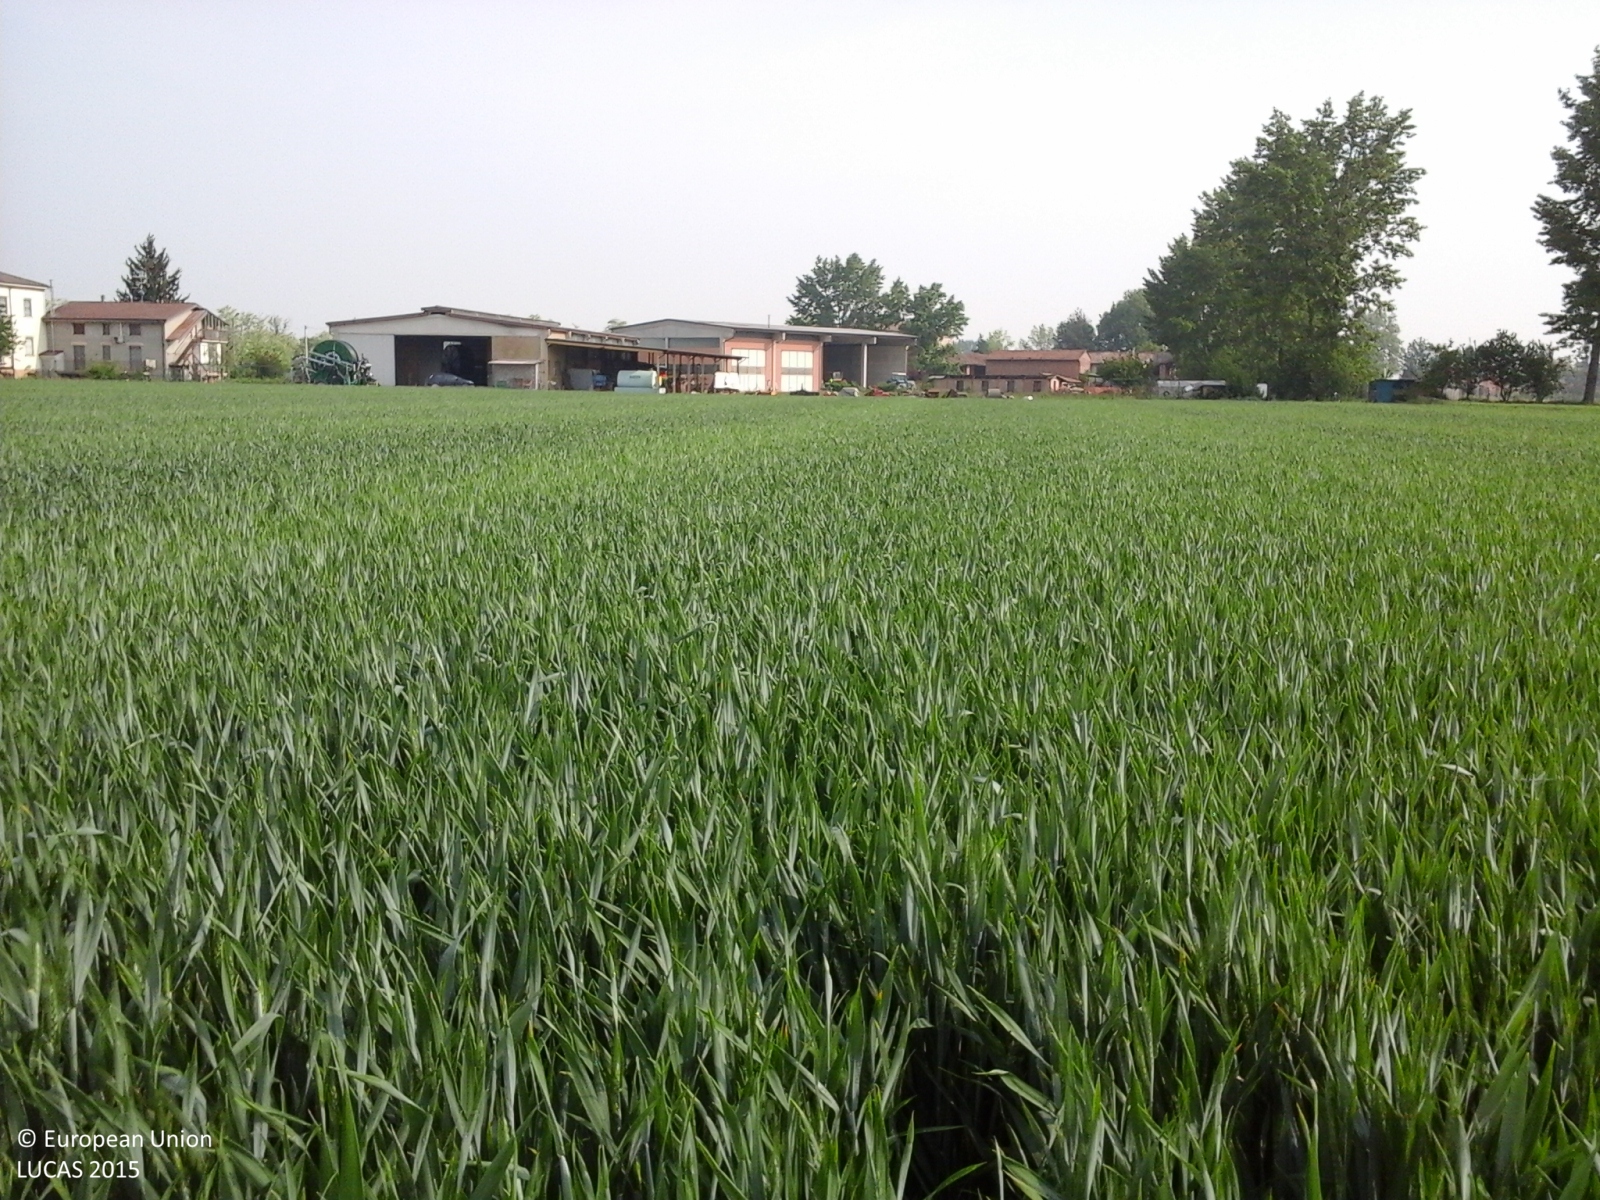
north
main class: Cropland
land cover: Common wheat
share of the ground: > 75 %
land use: Agriculture (excluding fallow land and kitchen gardens)
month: May
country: IT
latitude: 45.0171
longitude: 9.6327
